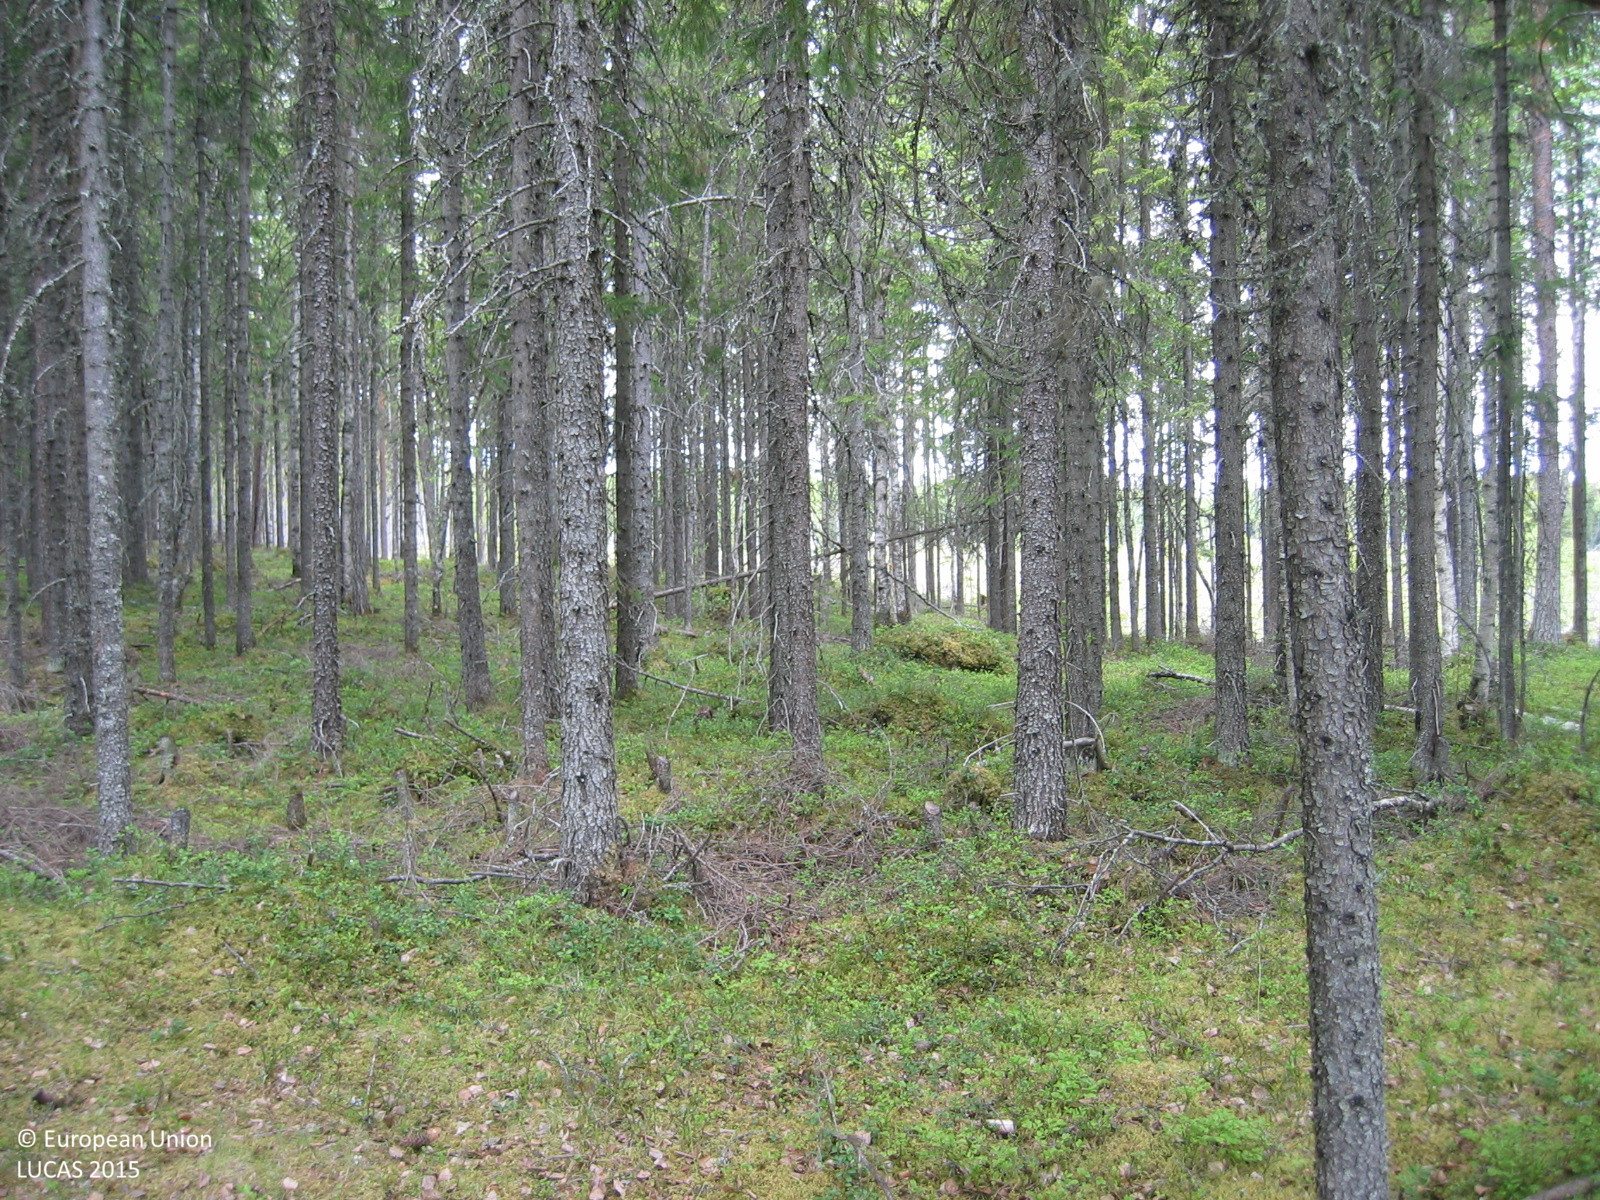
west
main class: Woodland
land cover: Spruce dominated coniferous woodland
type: boreal forest
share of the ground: > 75 %
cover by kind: coniferous forest trees 85 %, shrubs 10 %, broadleaved forest trees 5 %
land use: Forestry
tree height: > 5 m
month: June
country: SE
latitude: 63.5699
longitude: 14.6690
